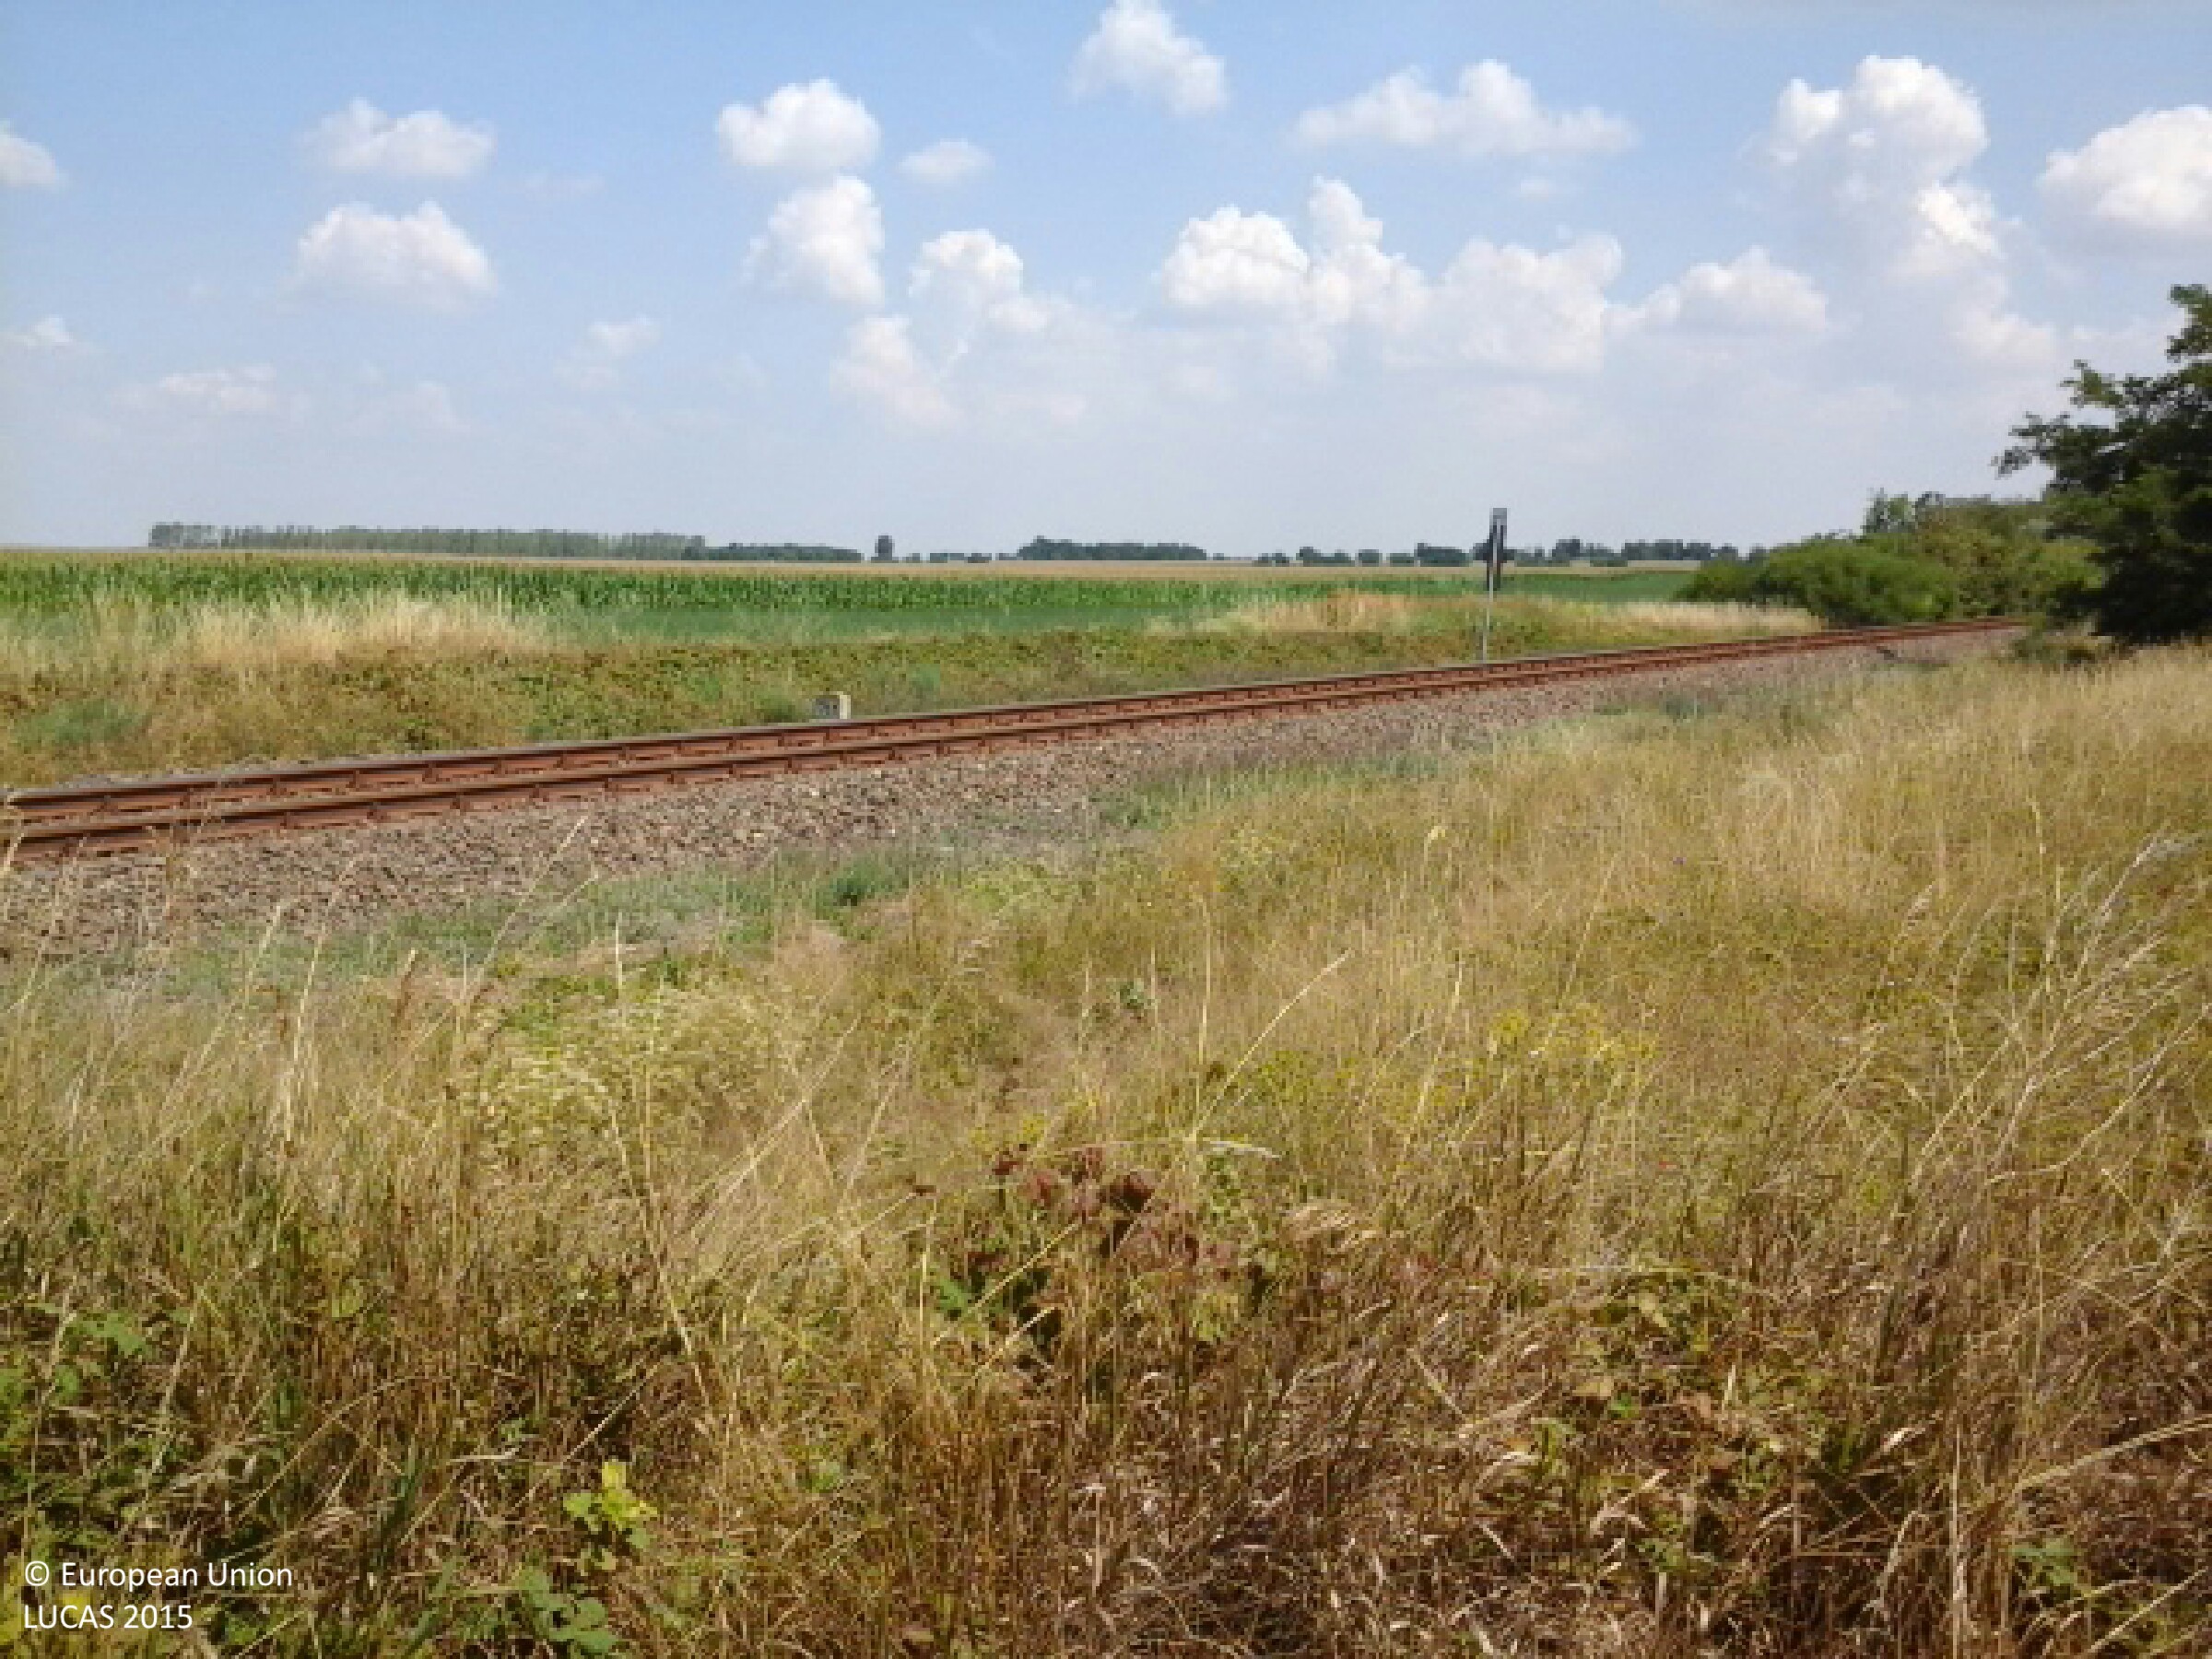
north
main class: Grassland
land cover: Spontaneously vegetated surfaces
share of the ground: > 75 %
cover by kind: herbaceous plants 95 %, shrubs 5 %
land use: Abandoned areas
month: August
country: HU
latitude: 47.6921
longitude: 18.0726
